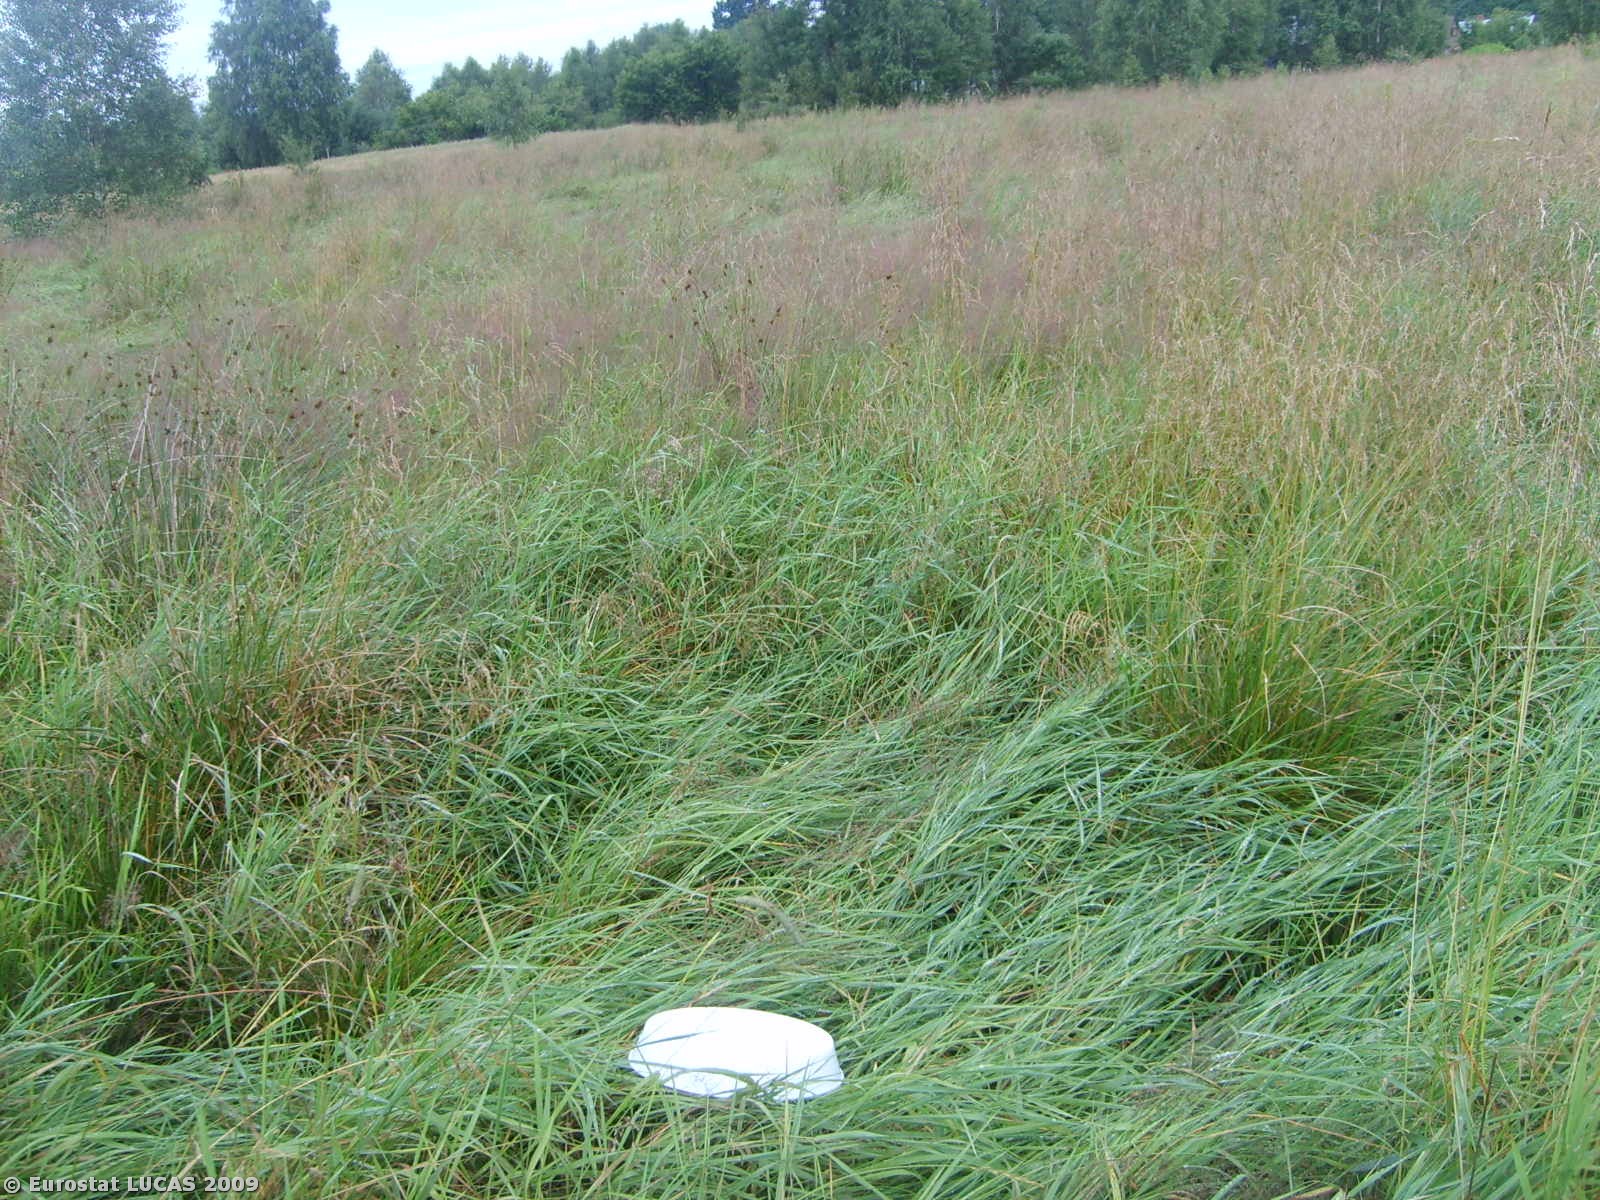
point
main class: Grassland
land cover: Grassland without tree/shrub cover
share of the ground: > 75 %
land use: Agriculture (excluding fallow land and kitchen gardens)
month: July
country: PL
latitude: 52.2950
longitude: 21.6215
